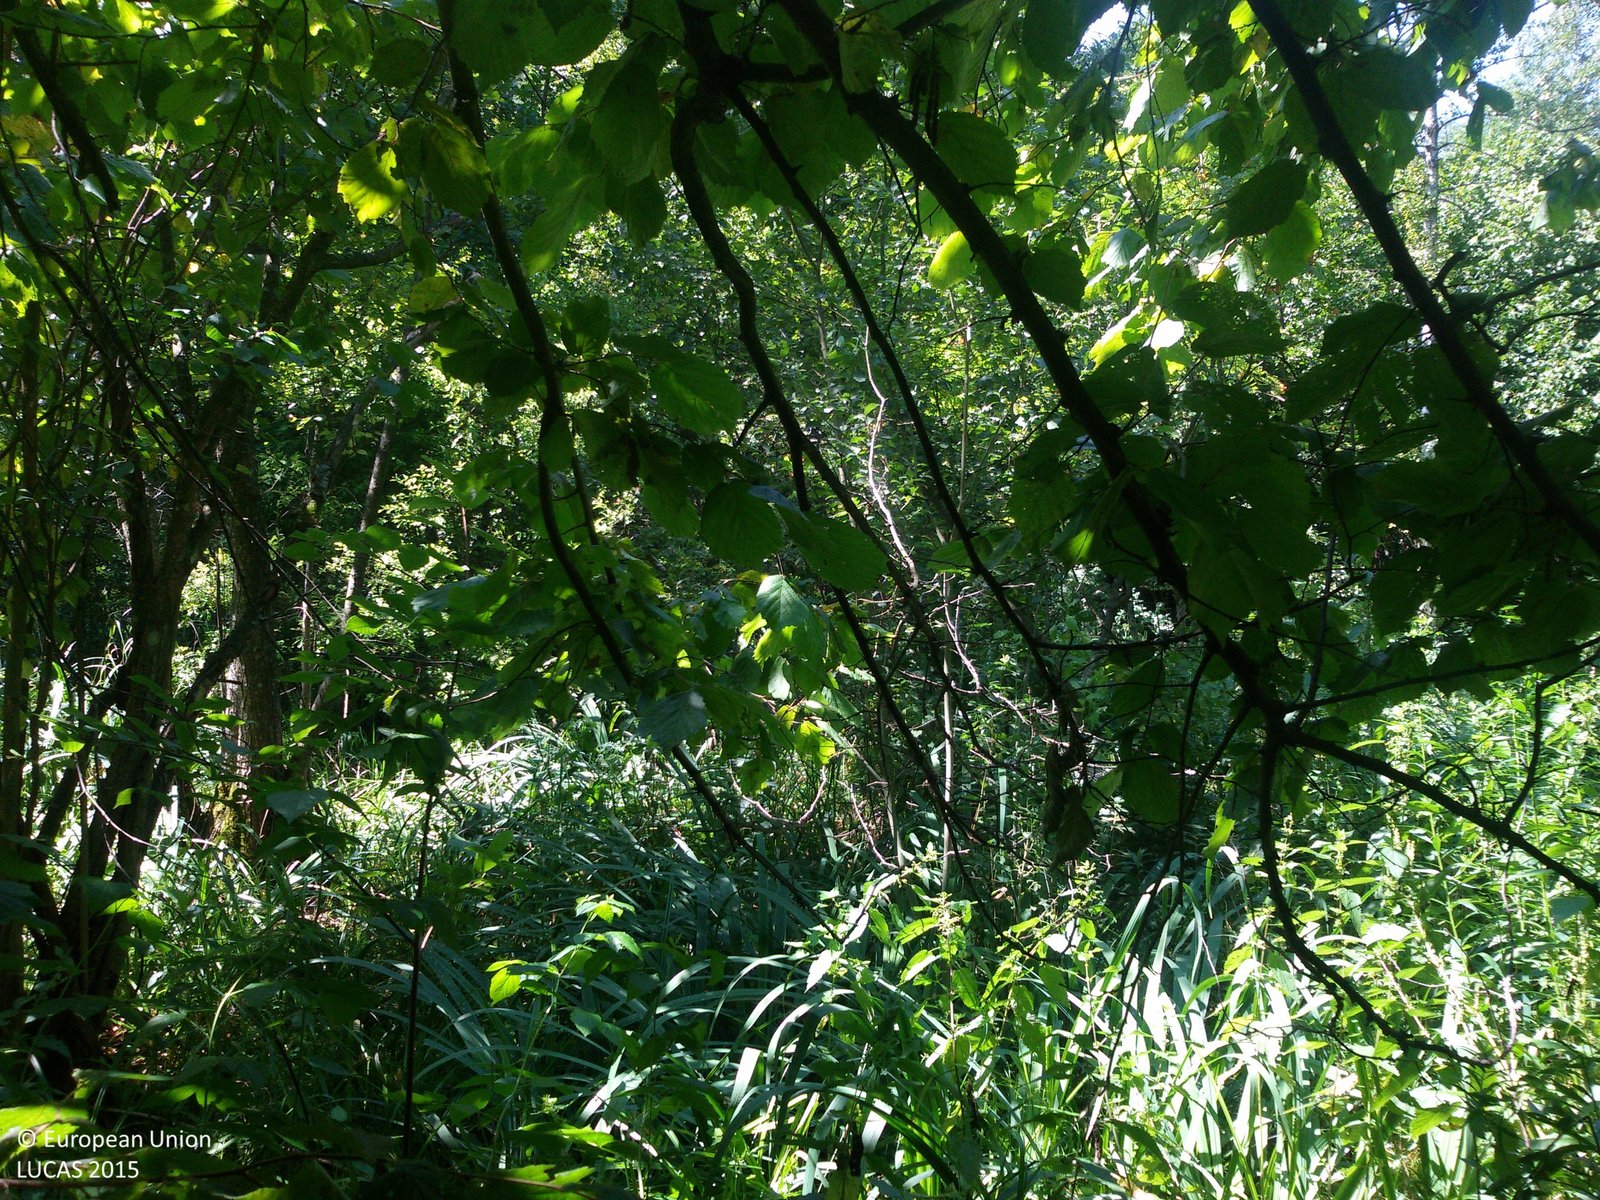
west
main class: Woodland
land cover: Broadleaved woodland
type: mesophytic deciduous forest
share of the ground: > 75 %
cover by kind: broadleaved forest trees 75 %, herbaceous plants 15 %, shrubs 10 %
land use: Forestry
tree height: > 5 m
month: July
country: PL
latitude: 51.5105
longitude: 23.4991
